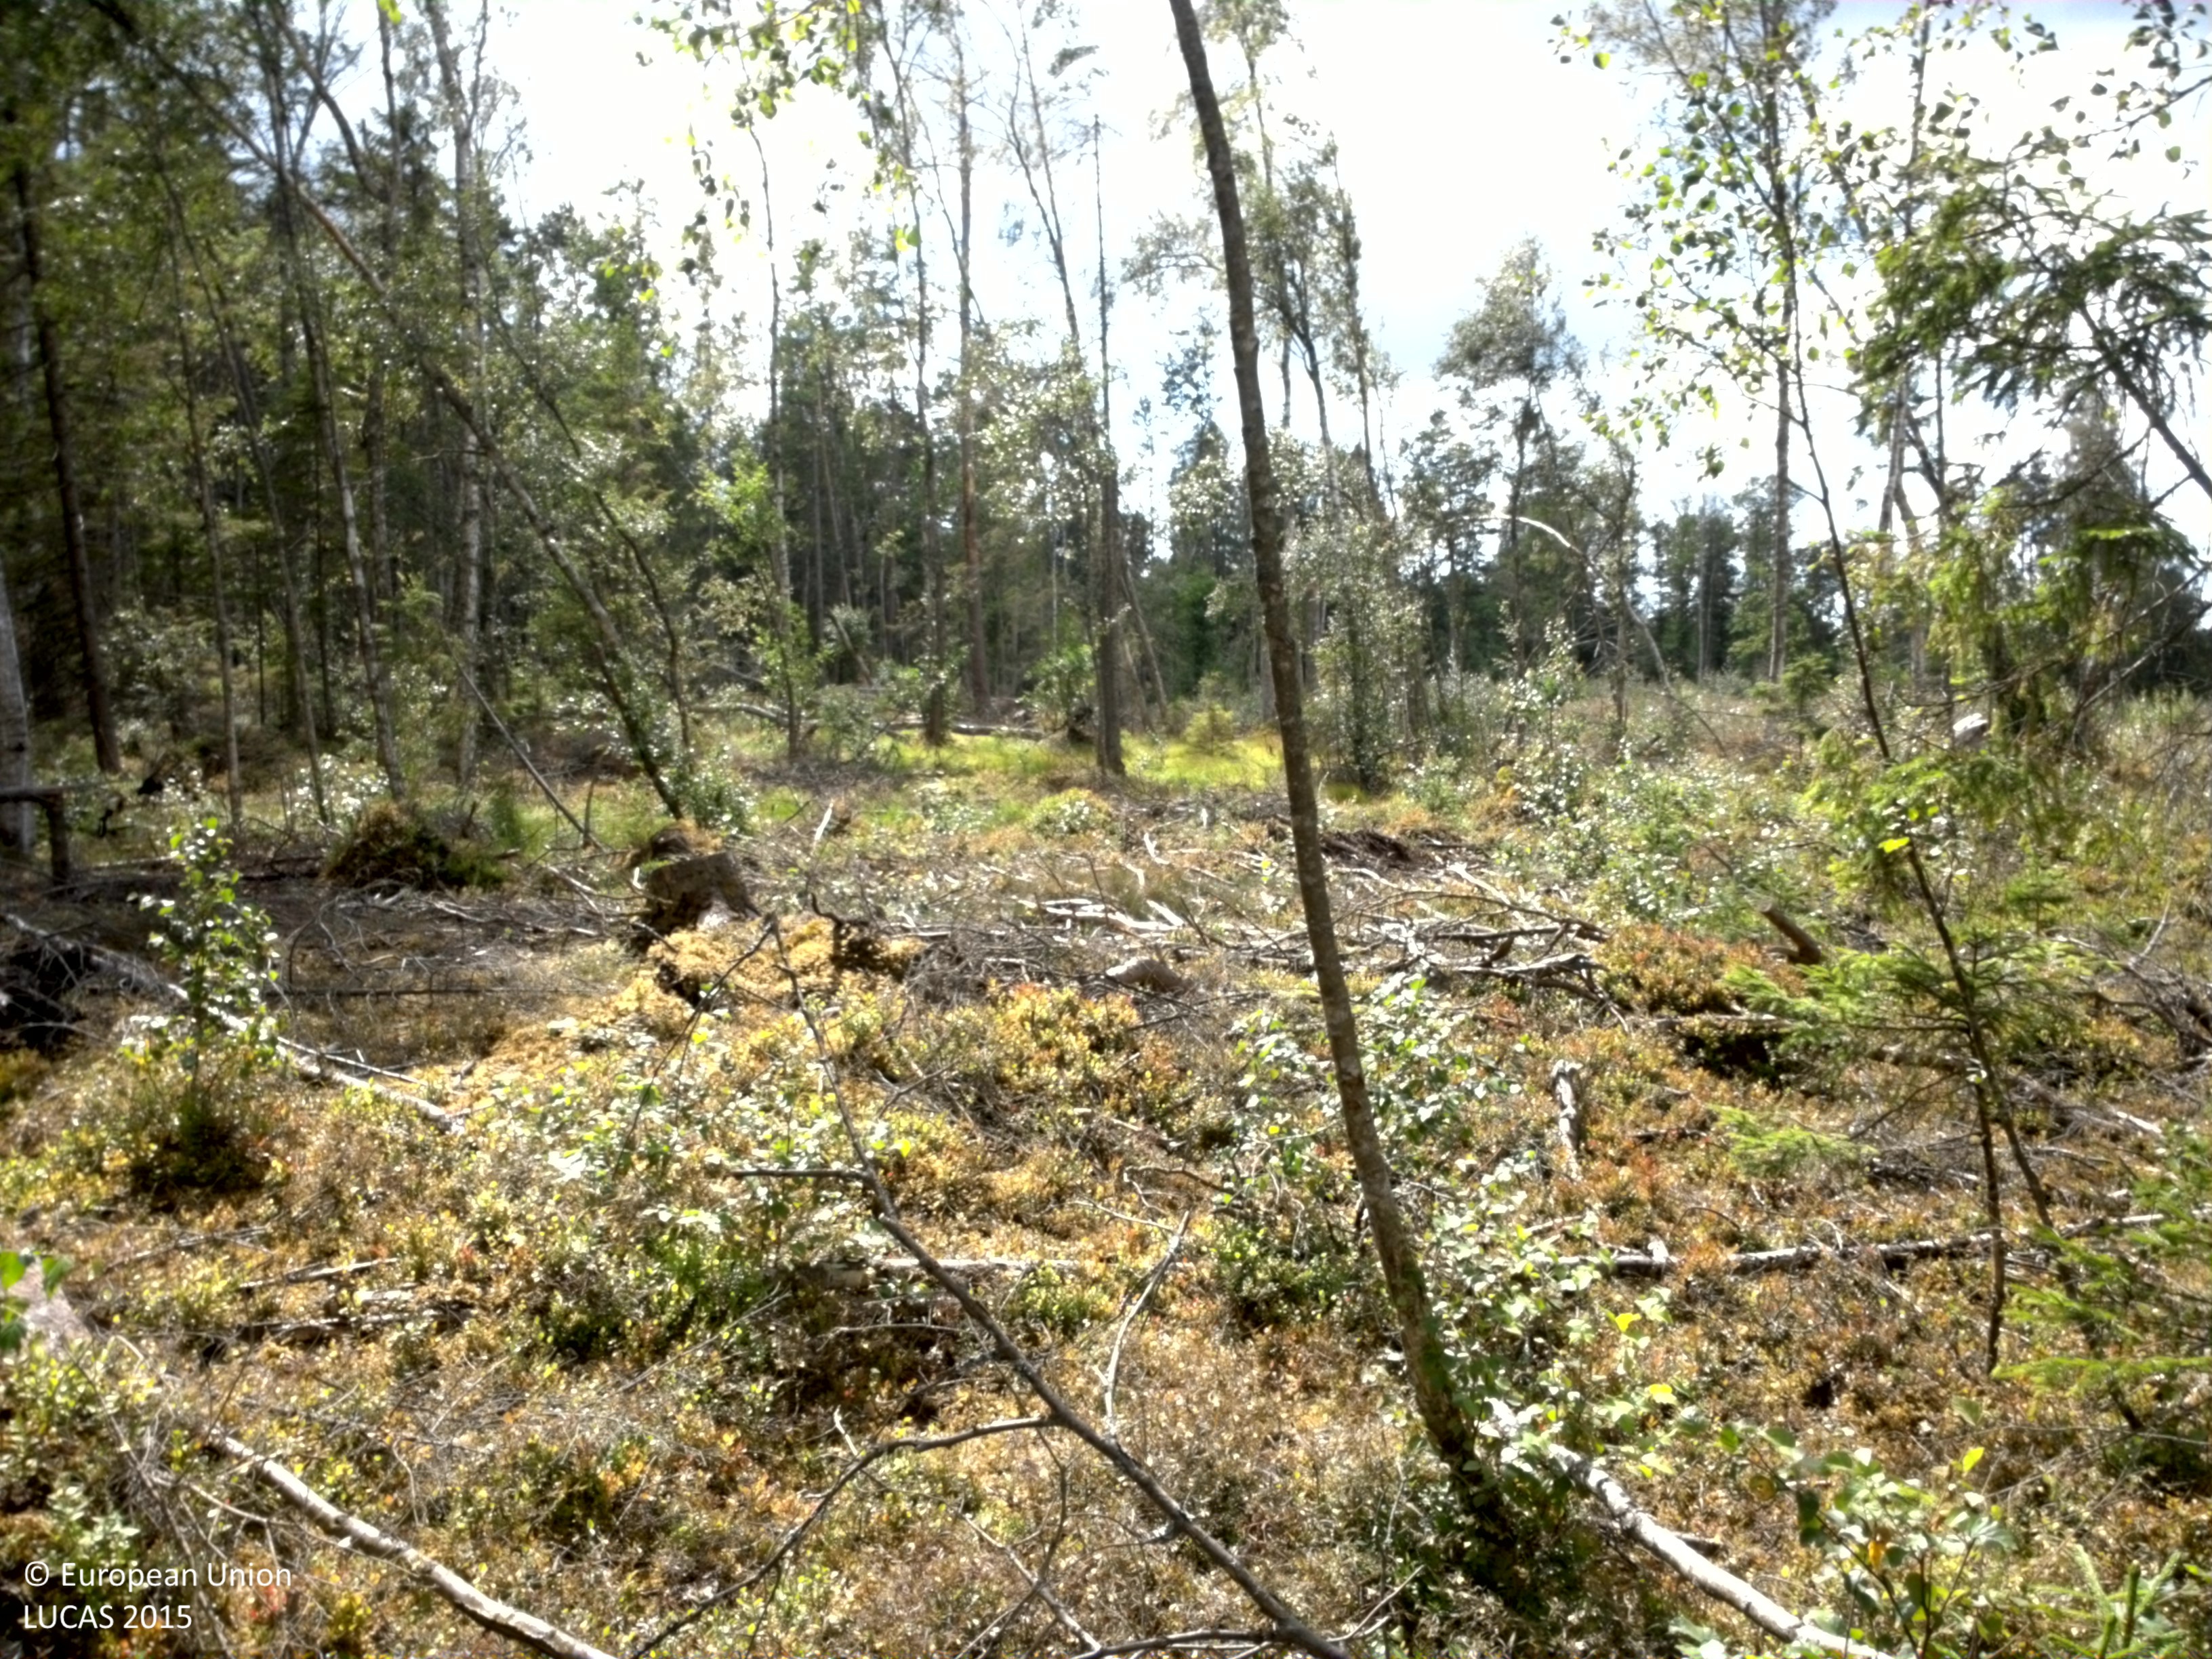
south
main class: Woodland
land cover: Spruce dominated coniferous woodland
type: boreal forest
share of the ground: 10 - 25 %
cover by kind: lichens and mosses 40 %, shrubs 25 %, coniferous forest trees 20 %, unconsolidated bare surface 10 %, broadleaved forest trees 5 %
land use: Forestry
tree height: > 5 m
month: July
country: SE
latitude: 58.7020
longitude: 13.9453
